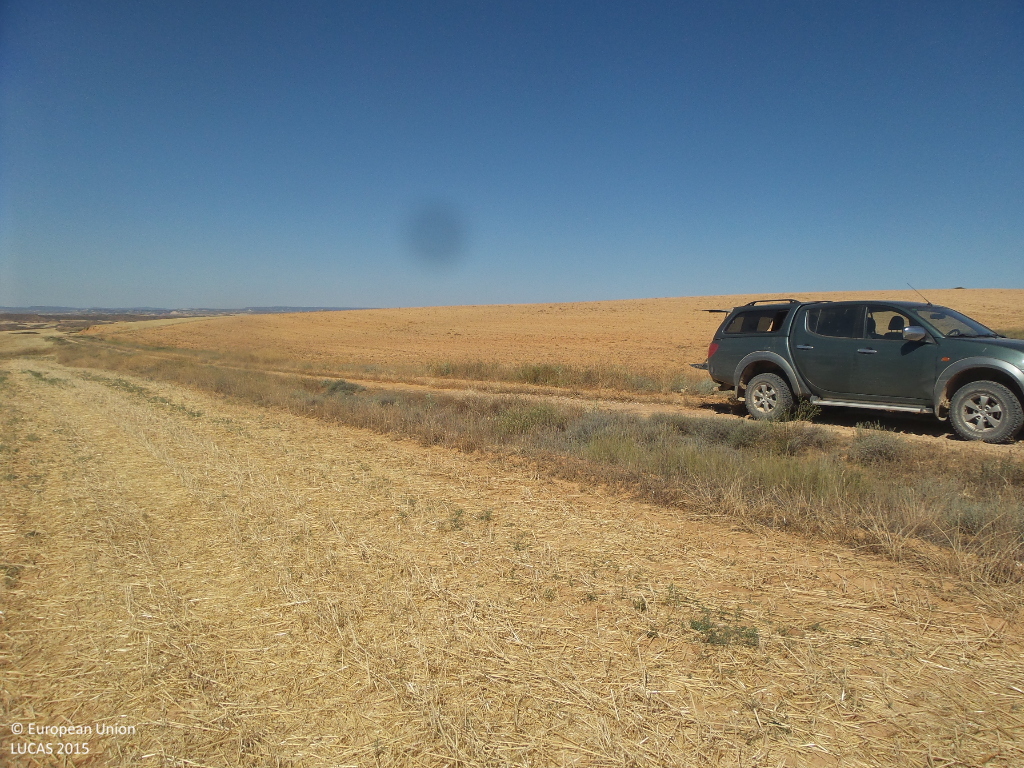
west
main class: Cropland
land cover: Common wheat
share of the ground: < 10 %
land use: Agriculture (excluding fallow land and kitchen gardens)
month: July
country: ES
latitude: 41.3405
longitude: -2.1113
